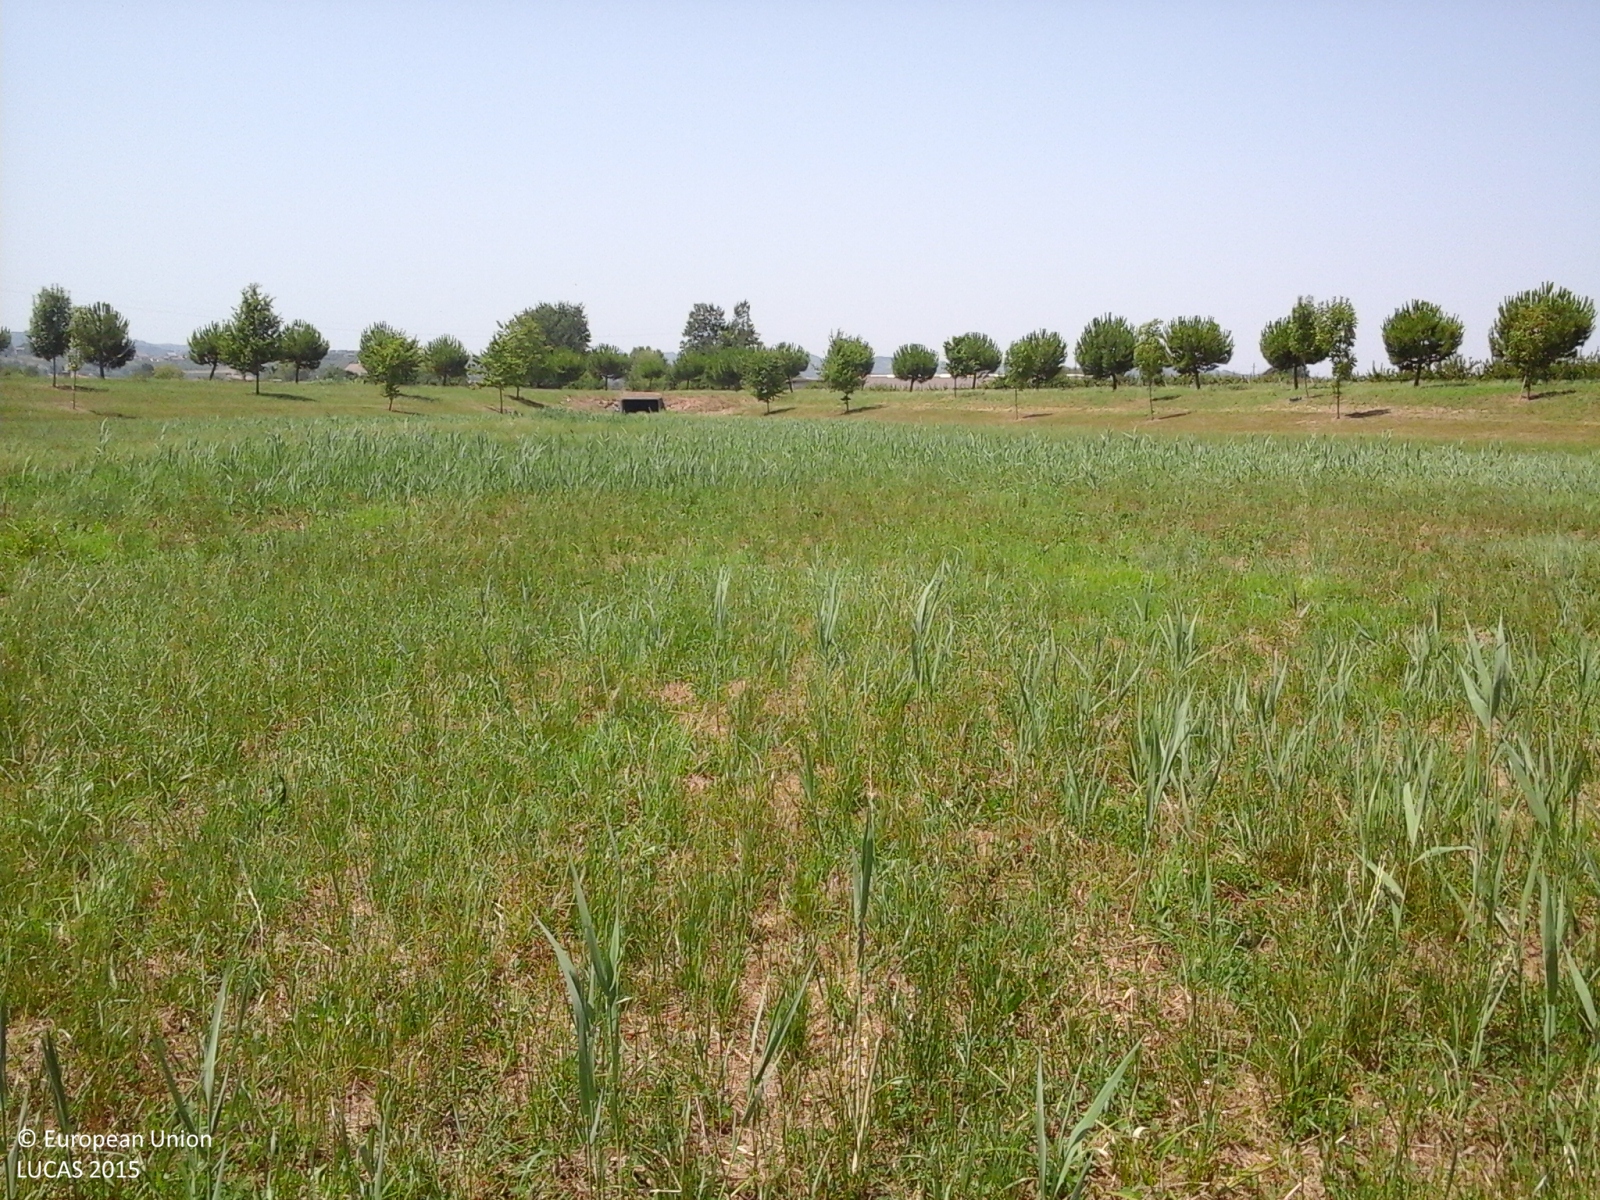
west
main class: Grassland
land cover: Spontaneously vegetated surfaces
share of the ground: > 75 %
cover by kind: herbaceous plants 100 %
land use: Fallow land
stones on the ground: < 10 %
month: July
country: IT
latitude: 44.1073
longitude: 12.3559
